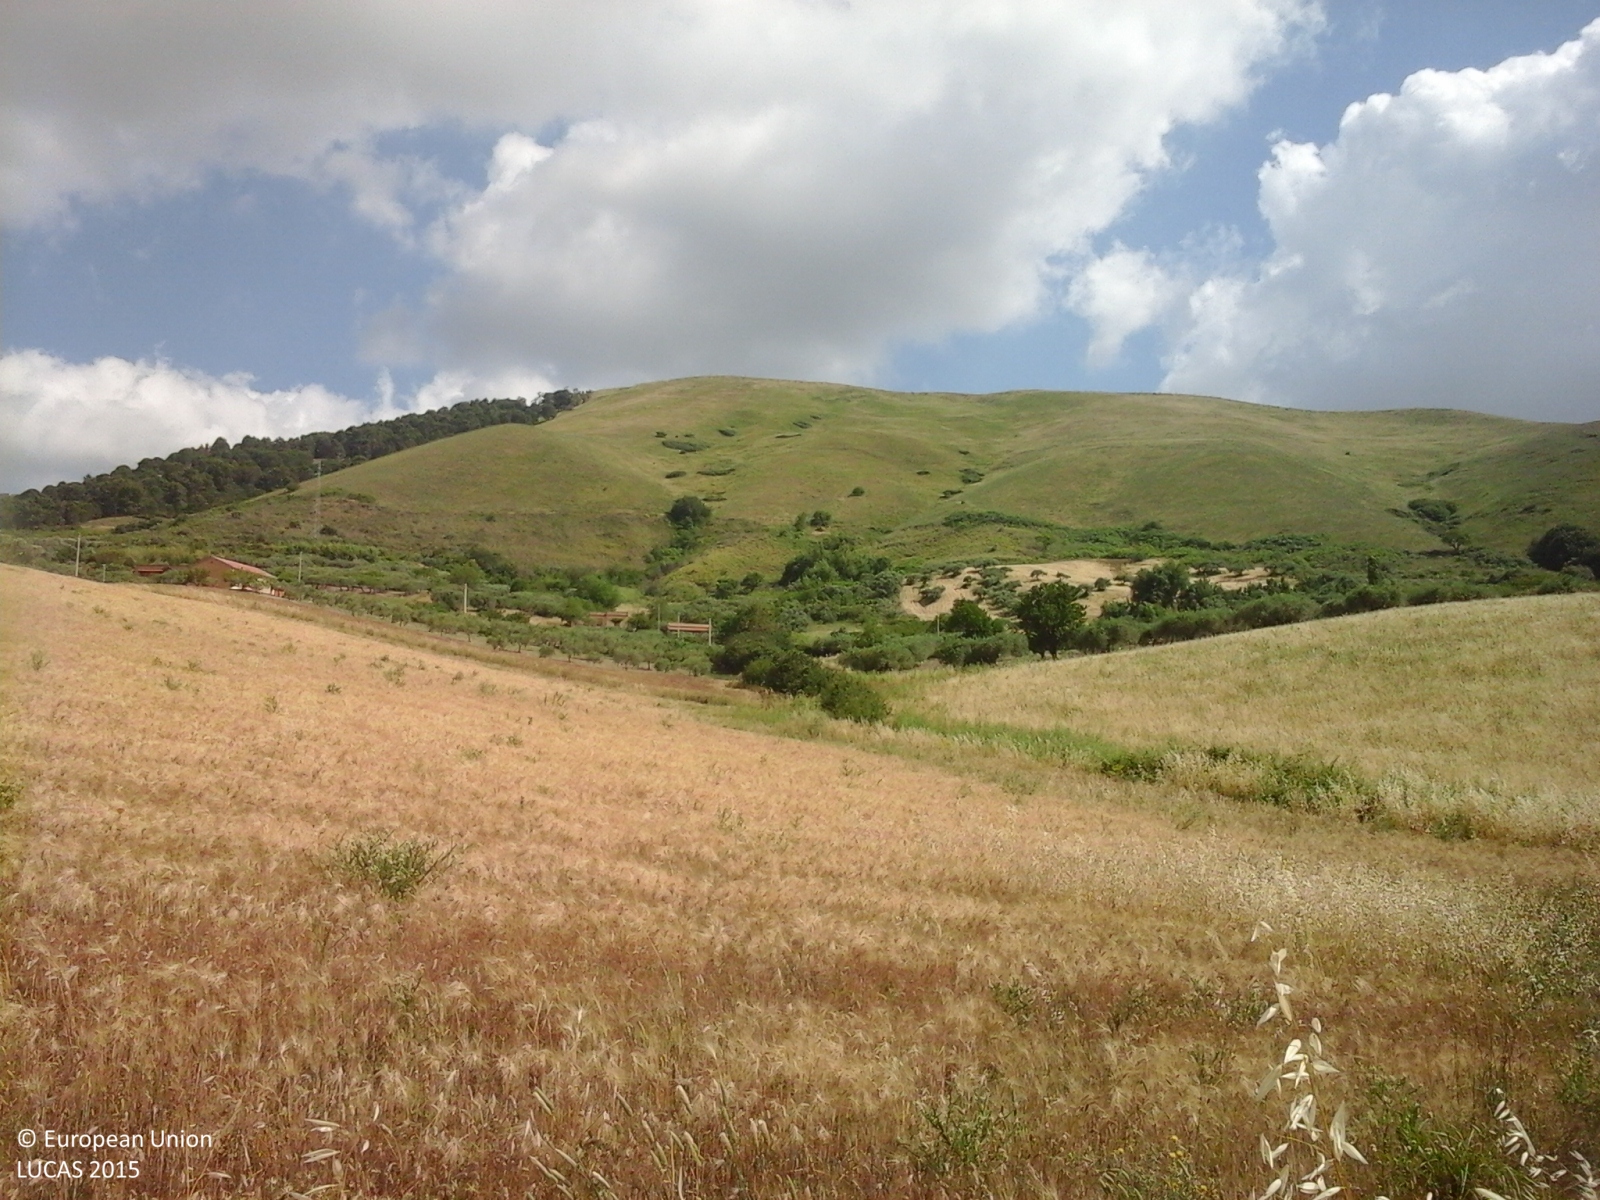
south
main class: Cropland
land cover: Durum wheat
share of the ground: > 75 %
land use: Agriculture (excluding fallow land and kitchen gardens)
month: June
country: IT
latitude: 37.7320
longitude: 13.1424
